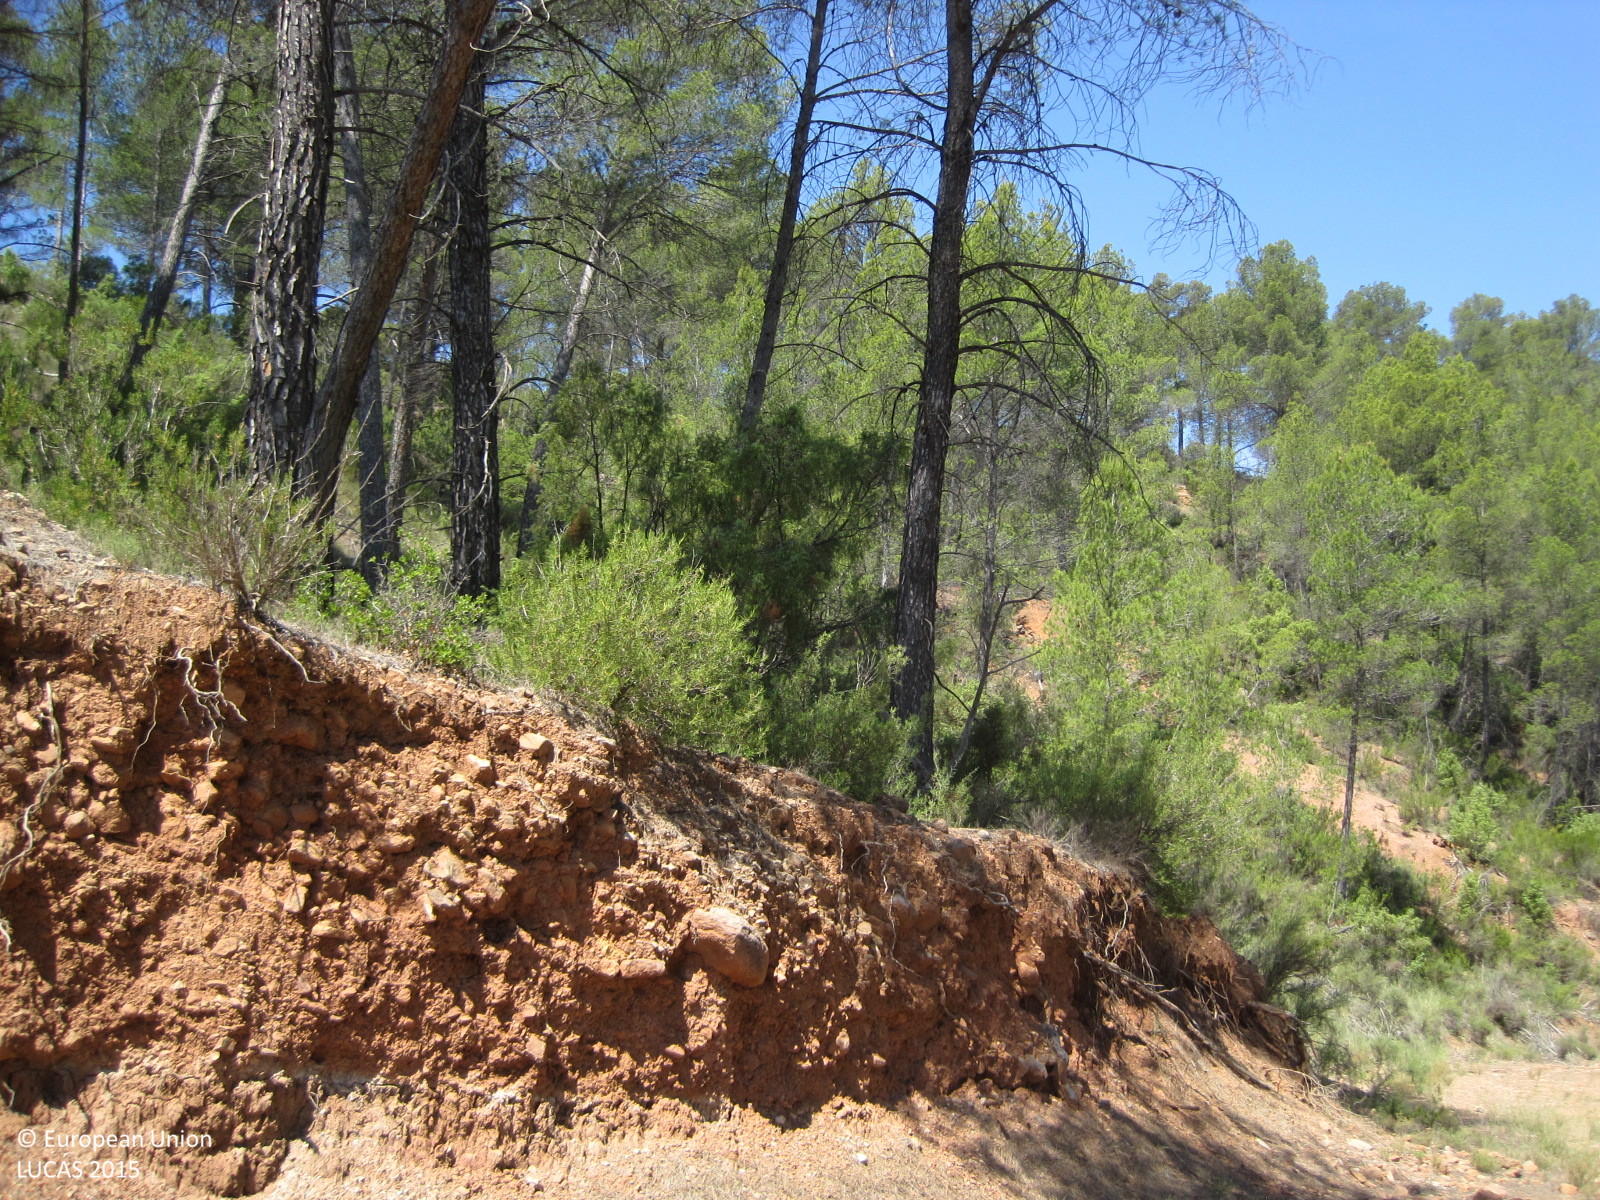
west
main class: Woodland
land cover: Pine dominated coniferous woodland
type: coniferous forest of the mediterranean region
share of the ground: 50 - 75 %
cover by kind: coniferous forest trees 70 %, shrubs 30 %
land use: Forestry
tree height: > 5 m
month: June
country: ES
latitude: 39.7599
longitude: -1.1284
